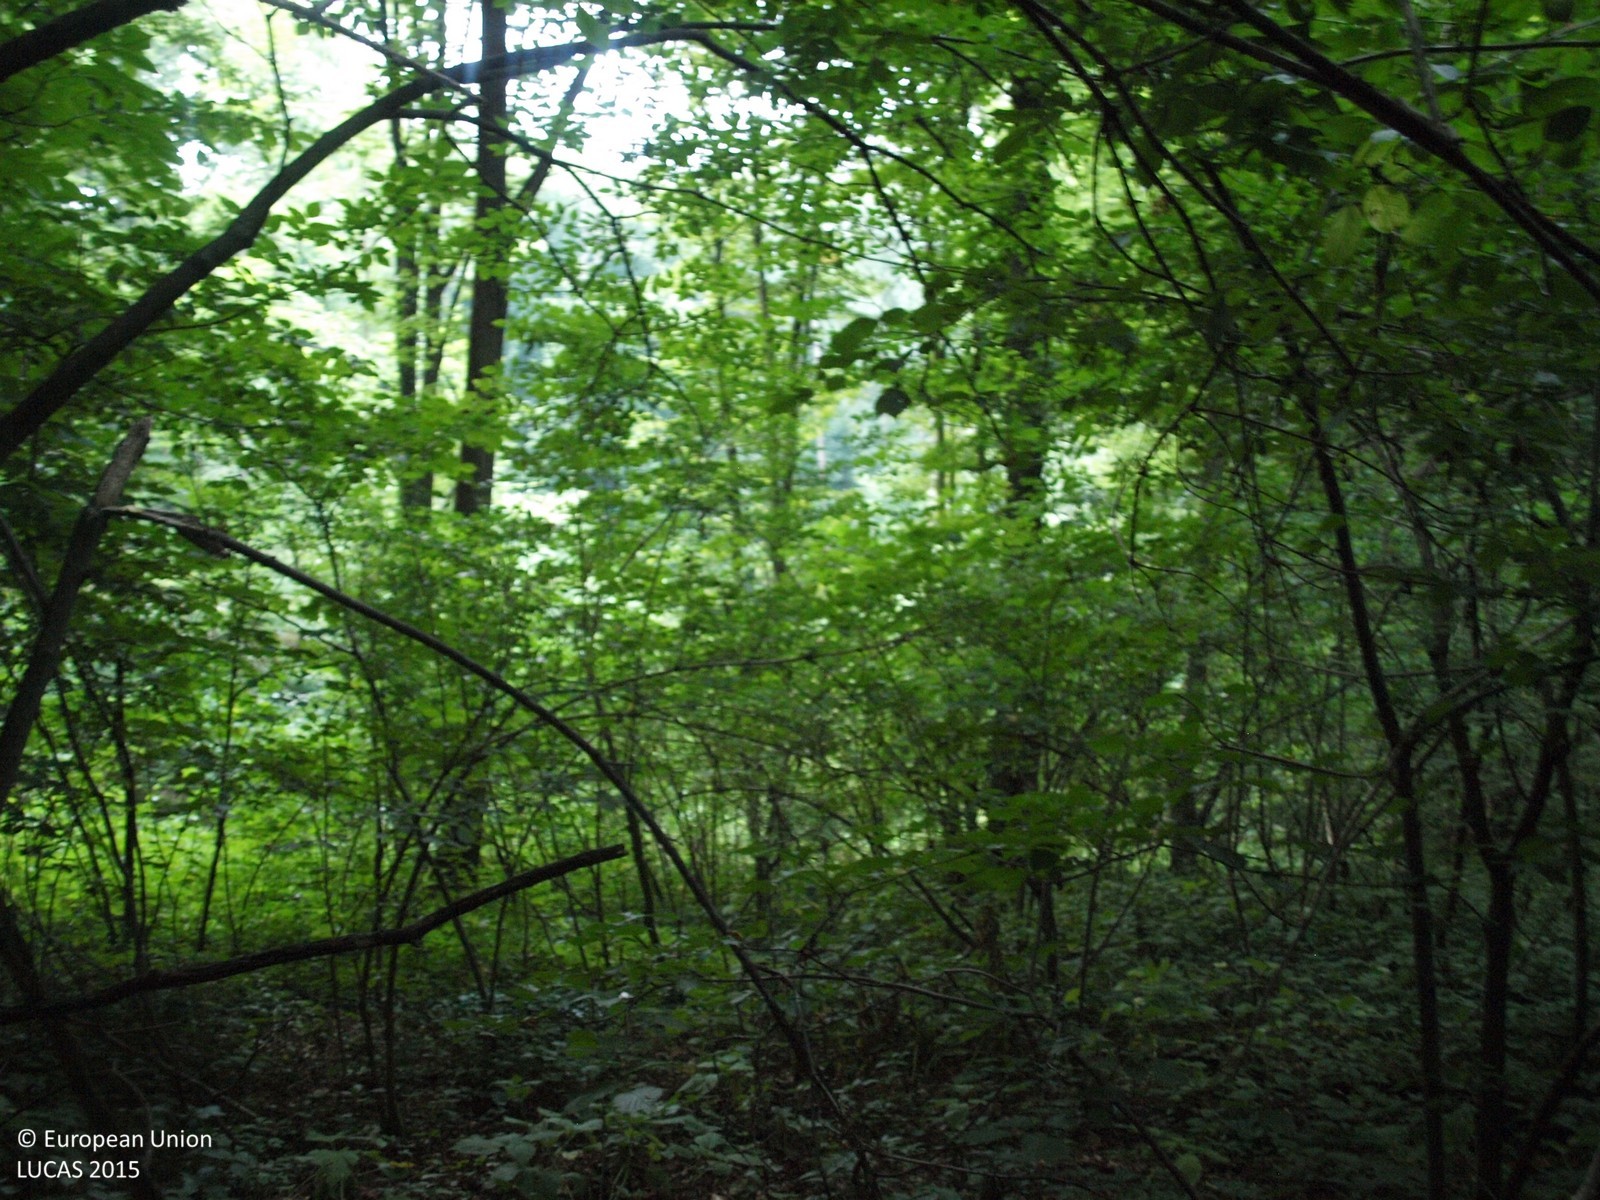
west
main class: Woodland
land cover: Broadleaved woodland
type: beech forest
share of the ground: > 75 %
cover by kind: broadleaved forest trees 100 %
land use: Forestry
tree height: > 5 m
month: July
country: HR
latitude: 46.2196
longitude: 16.5992
